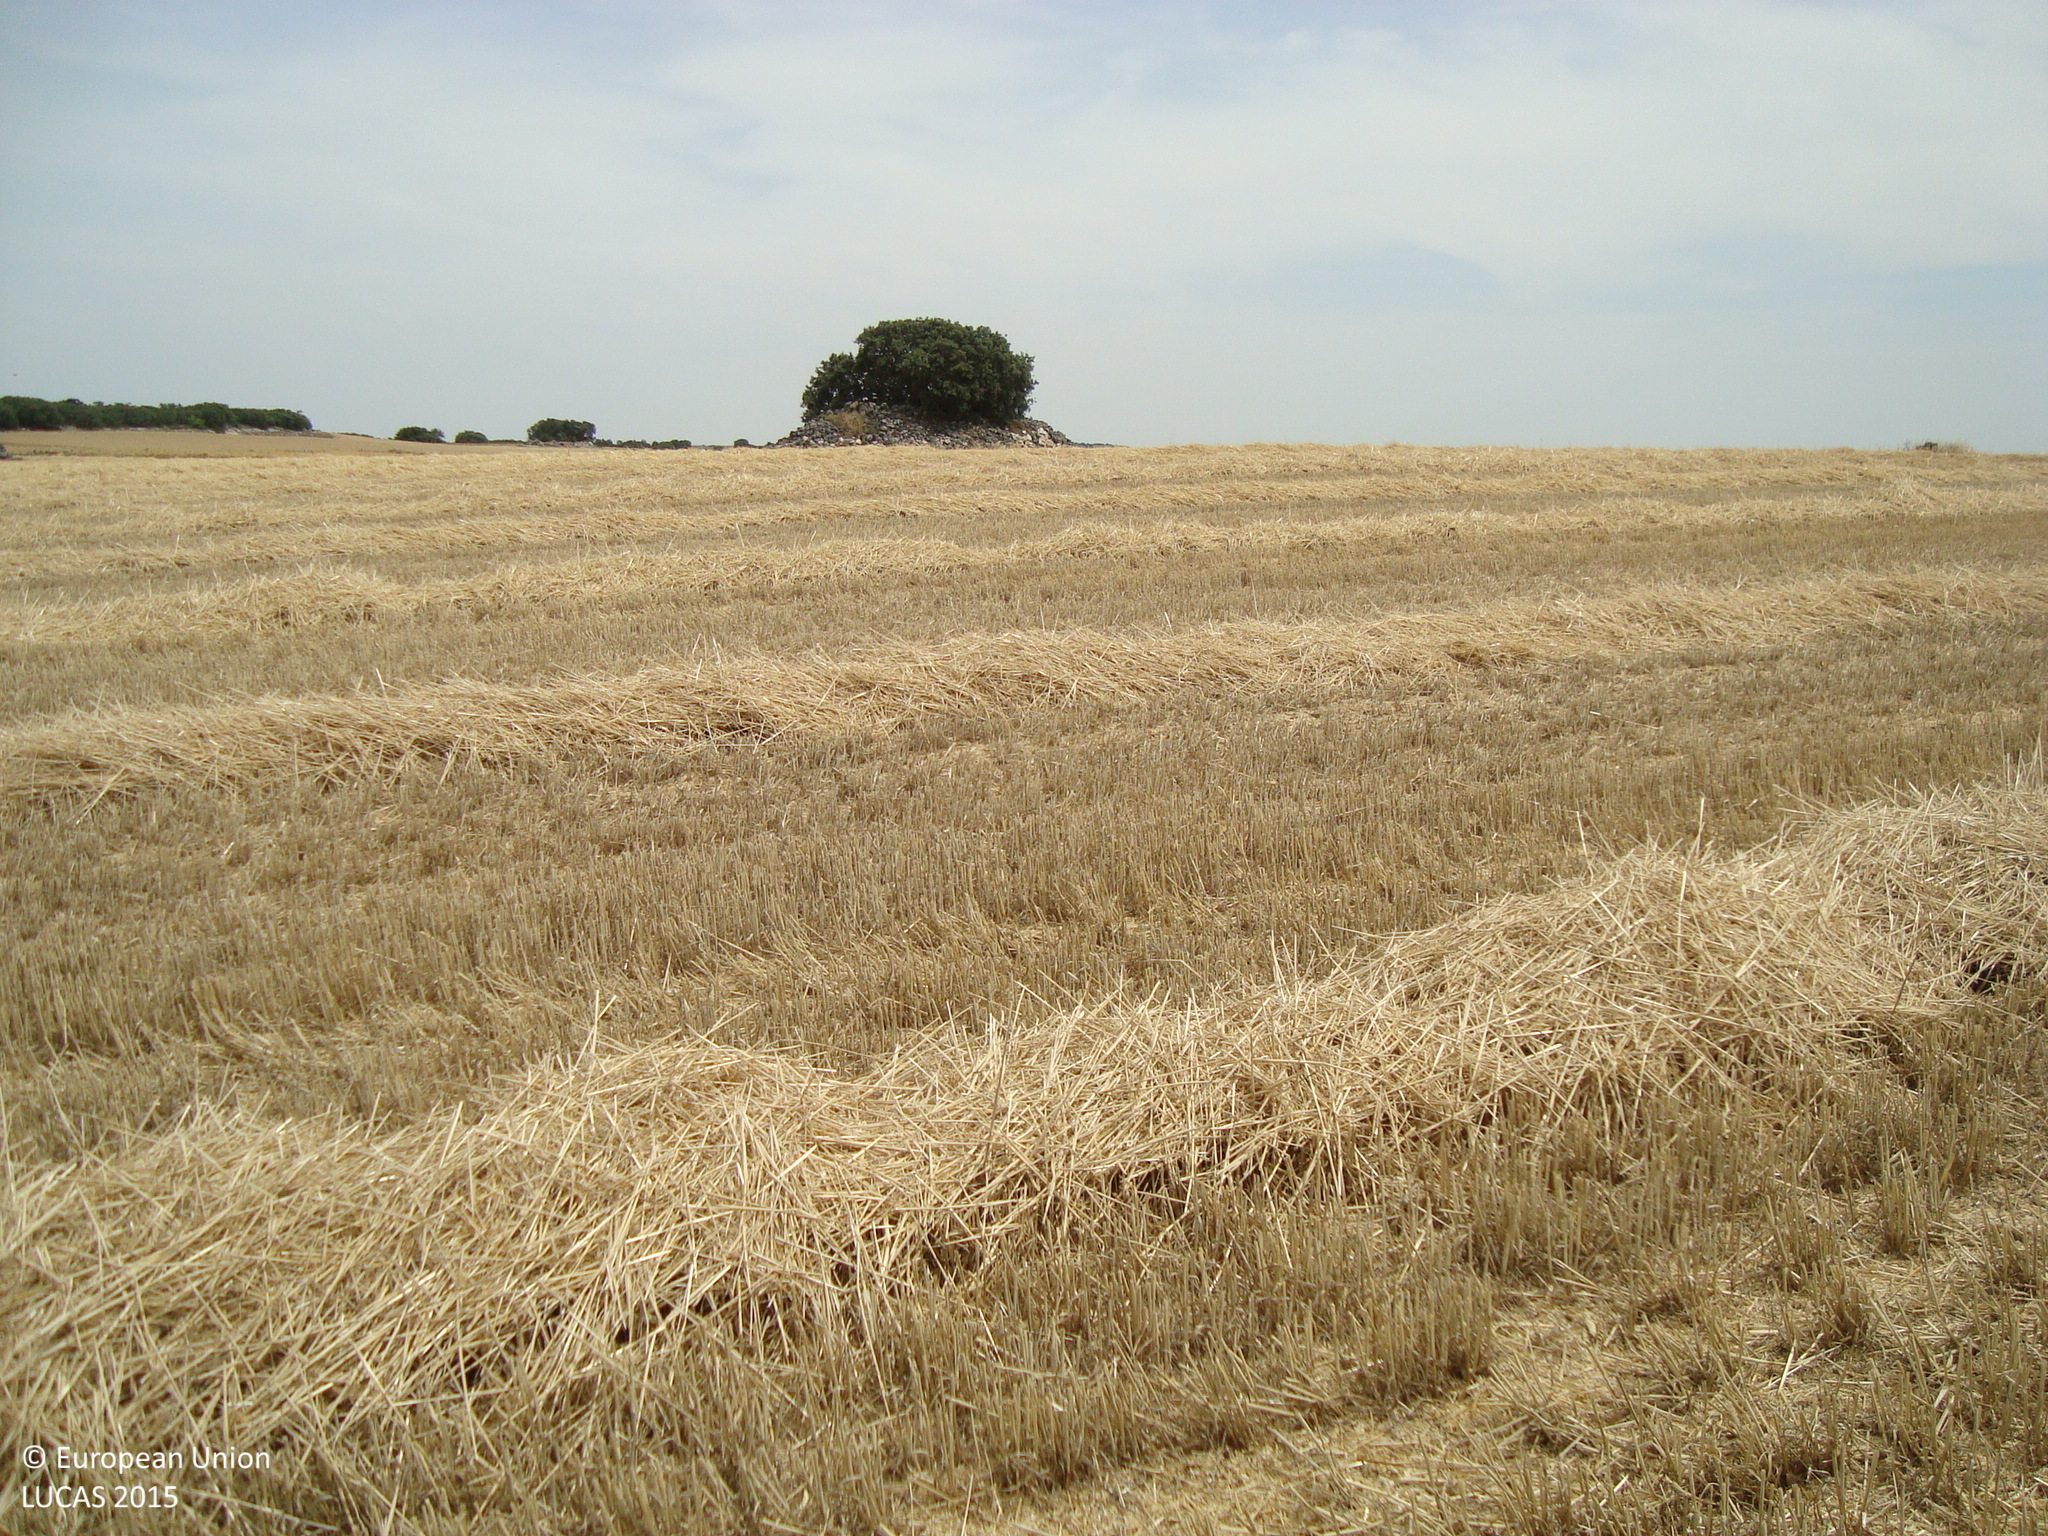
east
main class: Cropland
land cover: Common wheat
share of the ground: < 10 %
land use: Agriculture (excluding fallow land and kitchen gardens)
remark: Harvested field
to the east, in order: Common wheat; Dry stone walls; Single bushes/trees; Barley; Common wheat; Barley; Dry pulses
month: July
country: ES
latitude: 41.7898
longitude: -4.1033
